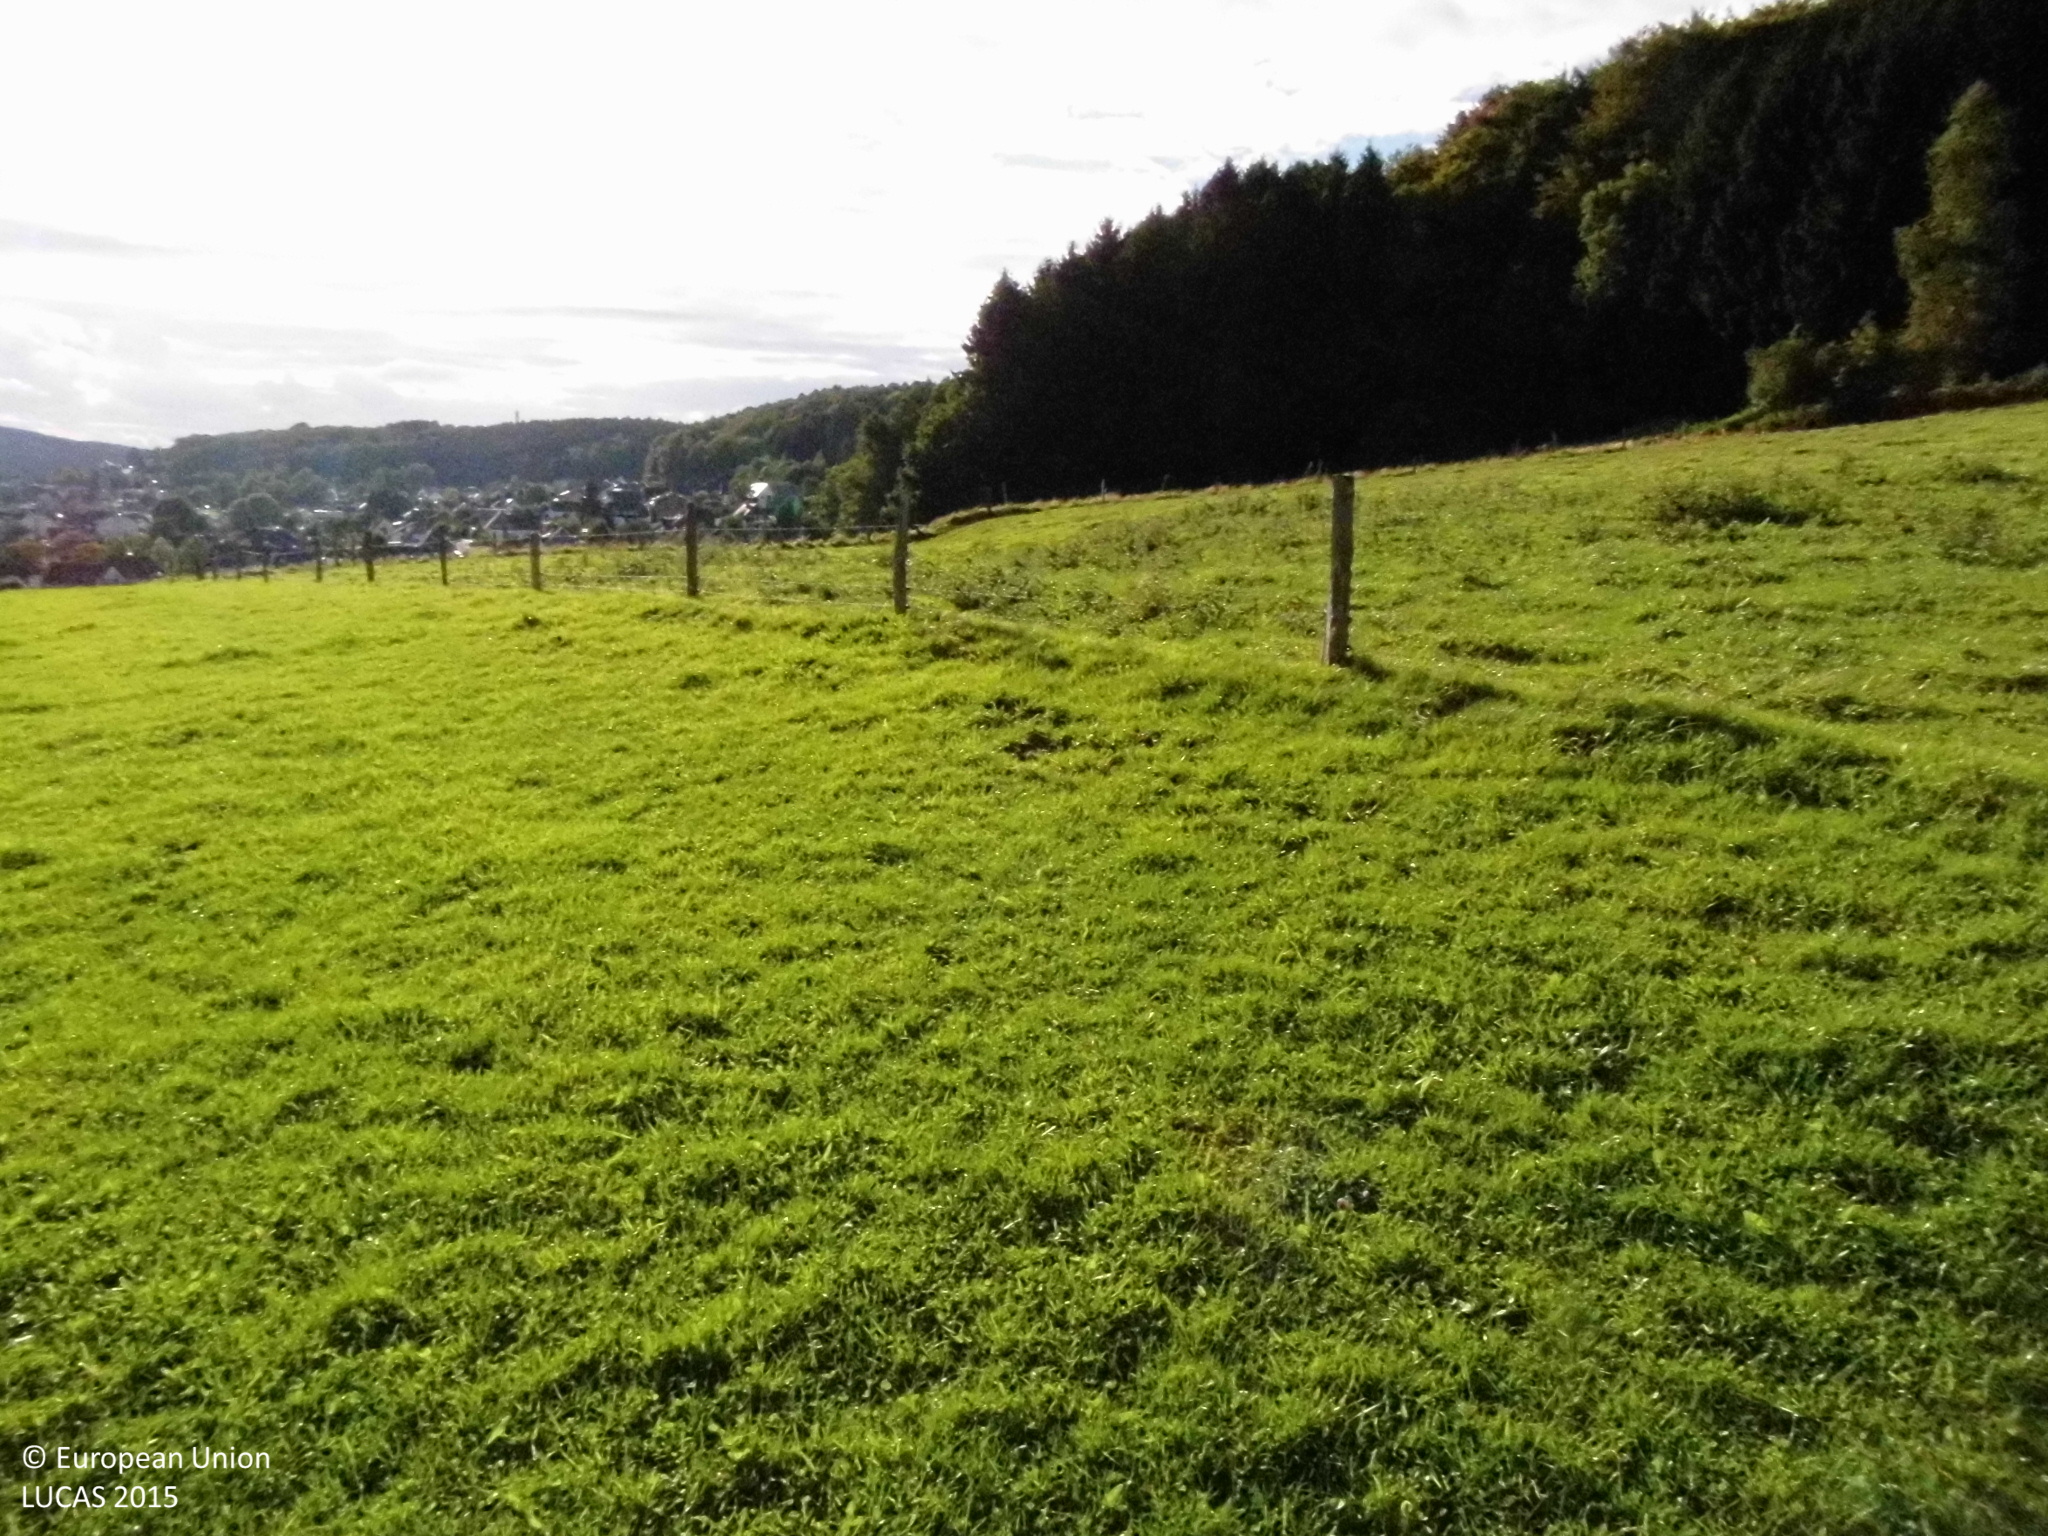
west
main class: Grassland
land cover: Grassland without tree/shrub cover
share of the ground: > 75 %
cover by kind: herbaceous plants 100 %
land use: Agriculture (excluding fallow land and kitchen gardens)
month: September
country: DE
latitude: 51.0551
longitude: 7.4465
